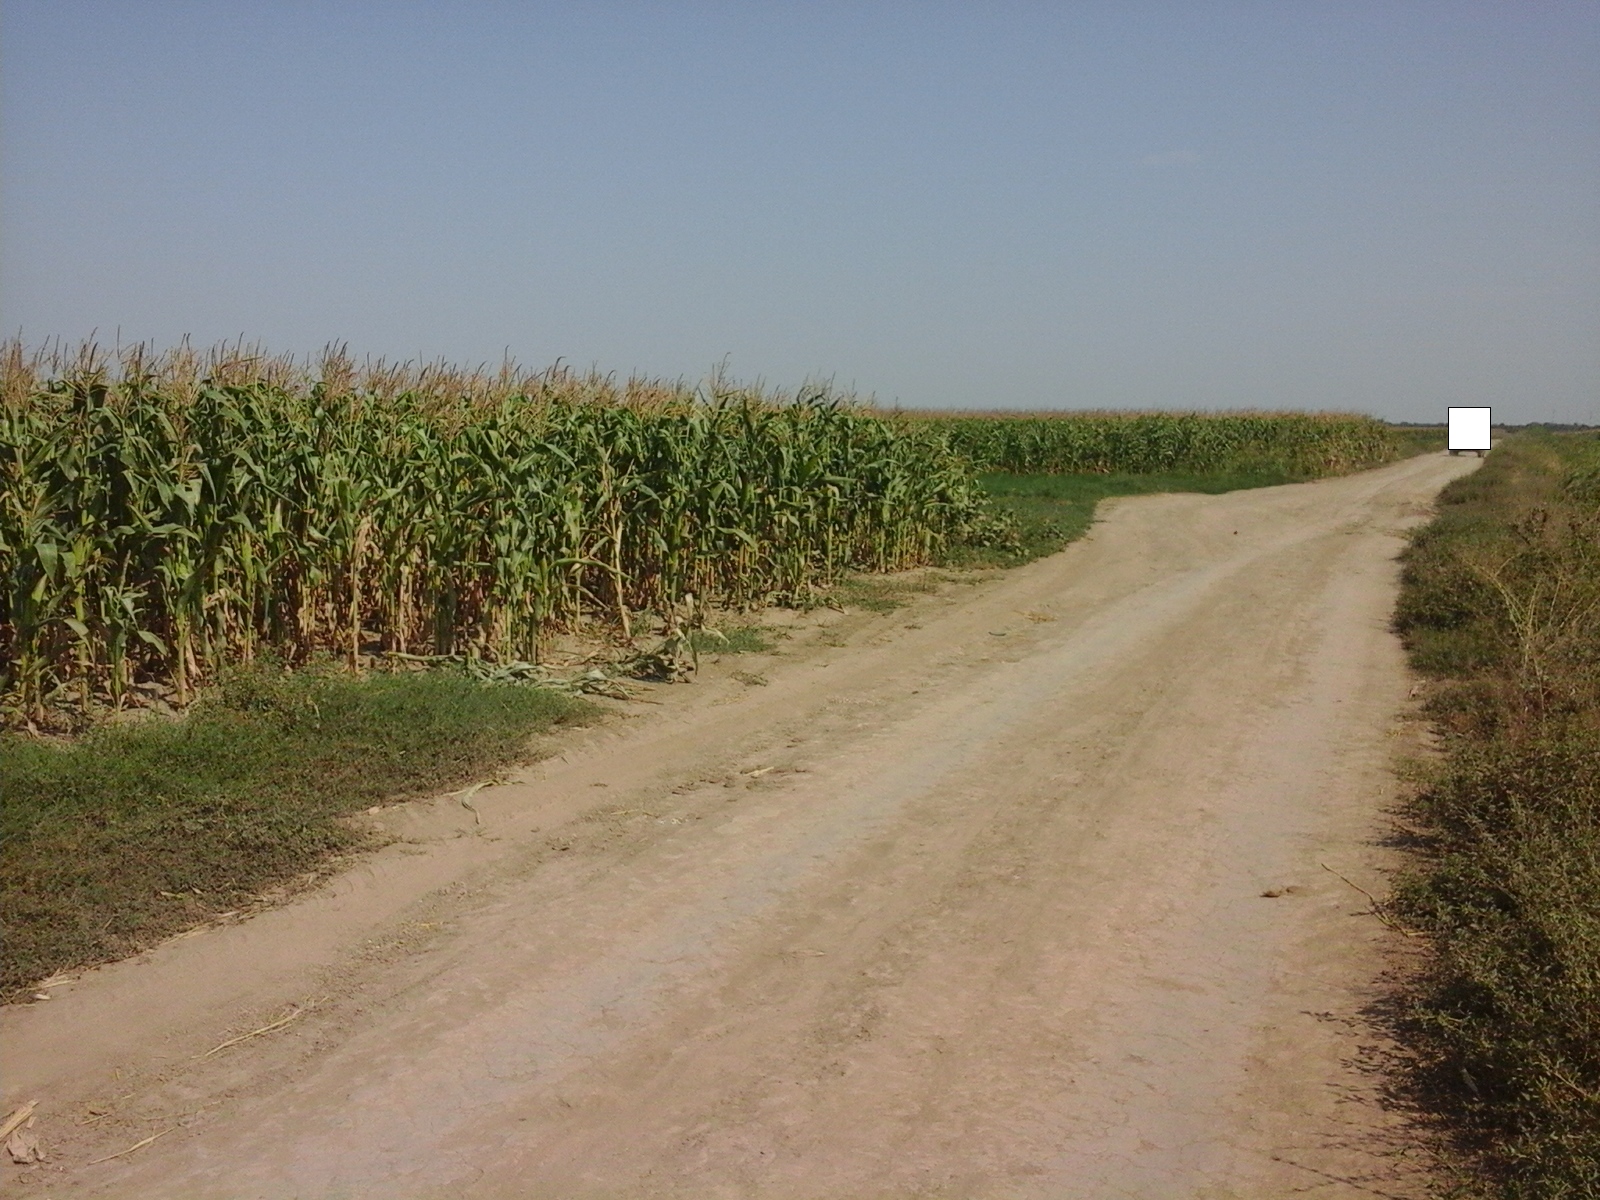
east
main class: Cropland
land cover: Maize
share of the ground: > 75 %
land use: Agriculture (excluding fallow land and kitchen gardens)
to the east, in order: Maize; Grass margins; Ditches and canals; Grass margins; Tracks; Lucerne
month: August
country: RO
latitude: 45.0593
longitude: 27.7182
